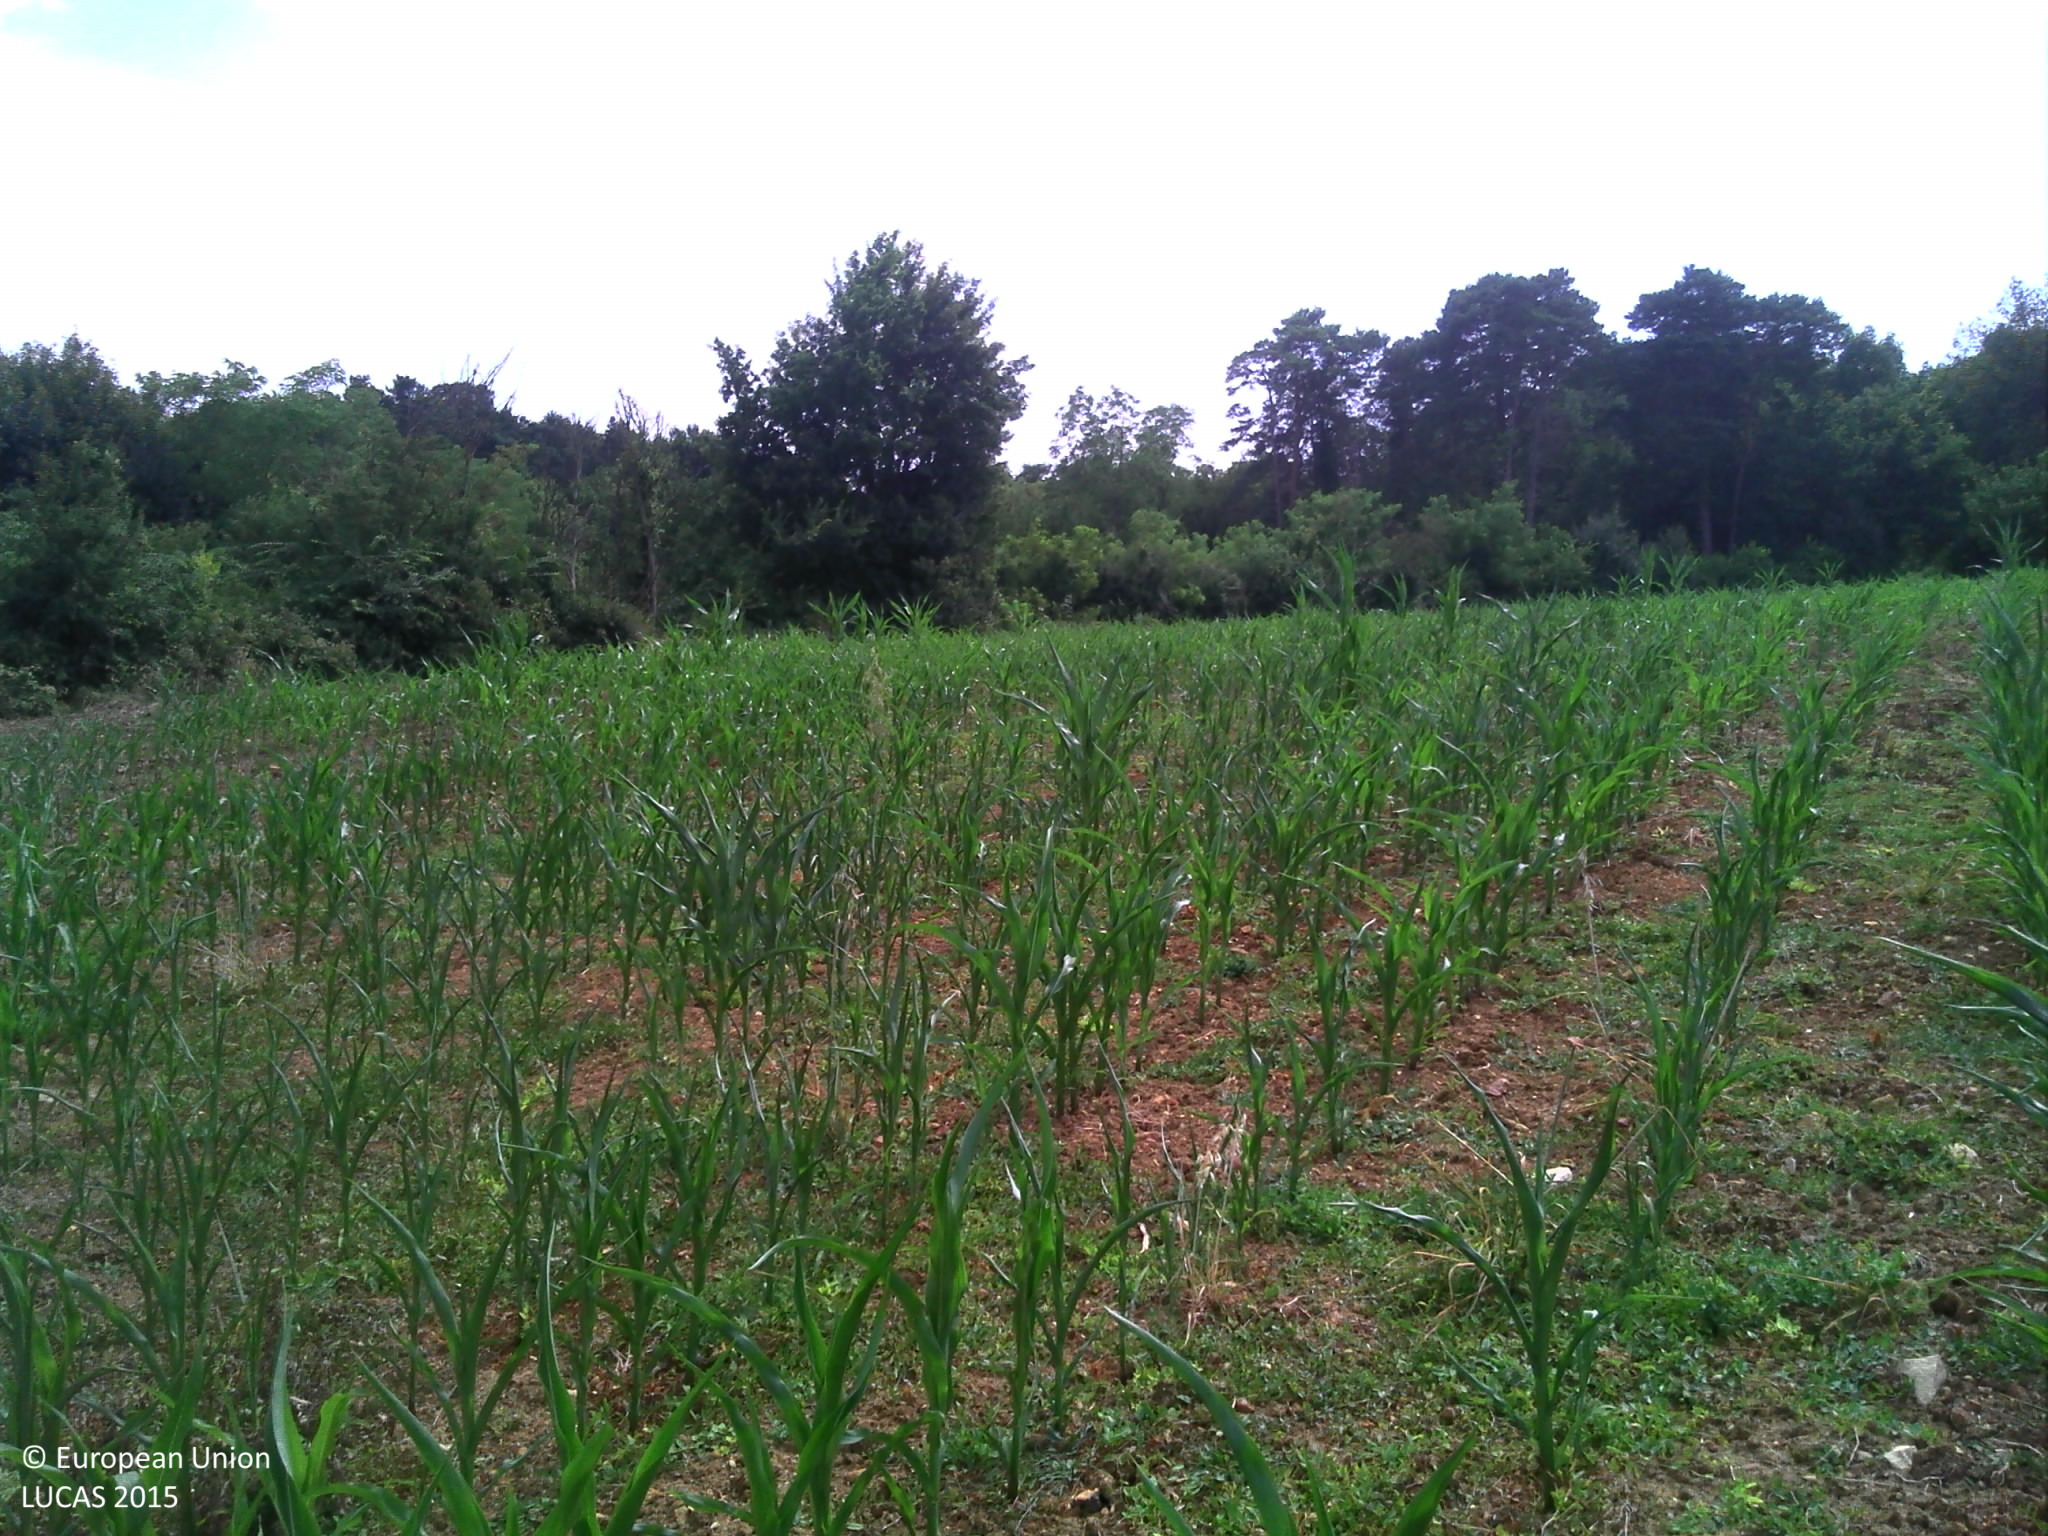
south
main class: Cropland
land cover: Maize
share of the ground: 25 - 50 %
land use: Agriculture (excluding fallow land and kitchen gardens)
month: July
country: FR
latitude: 47.2621
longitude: 0.4238
